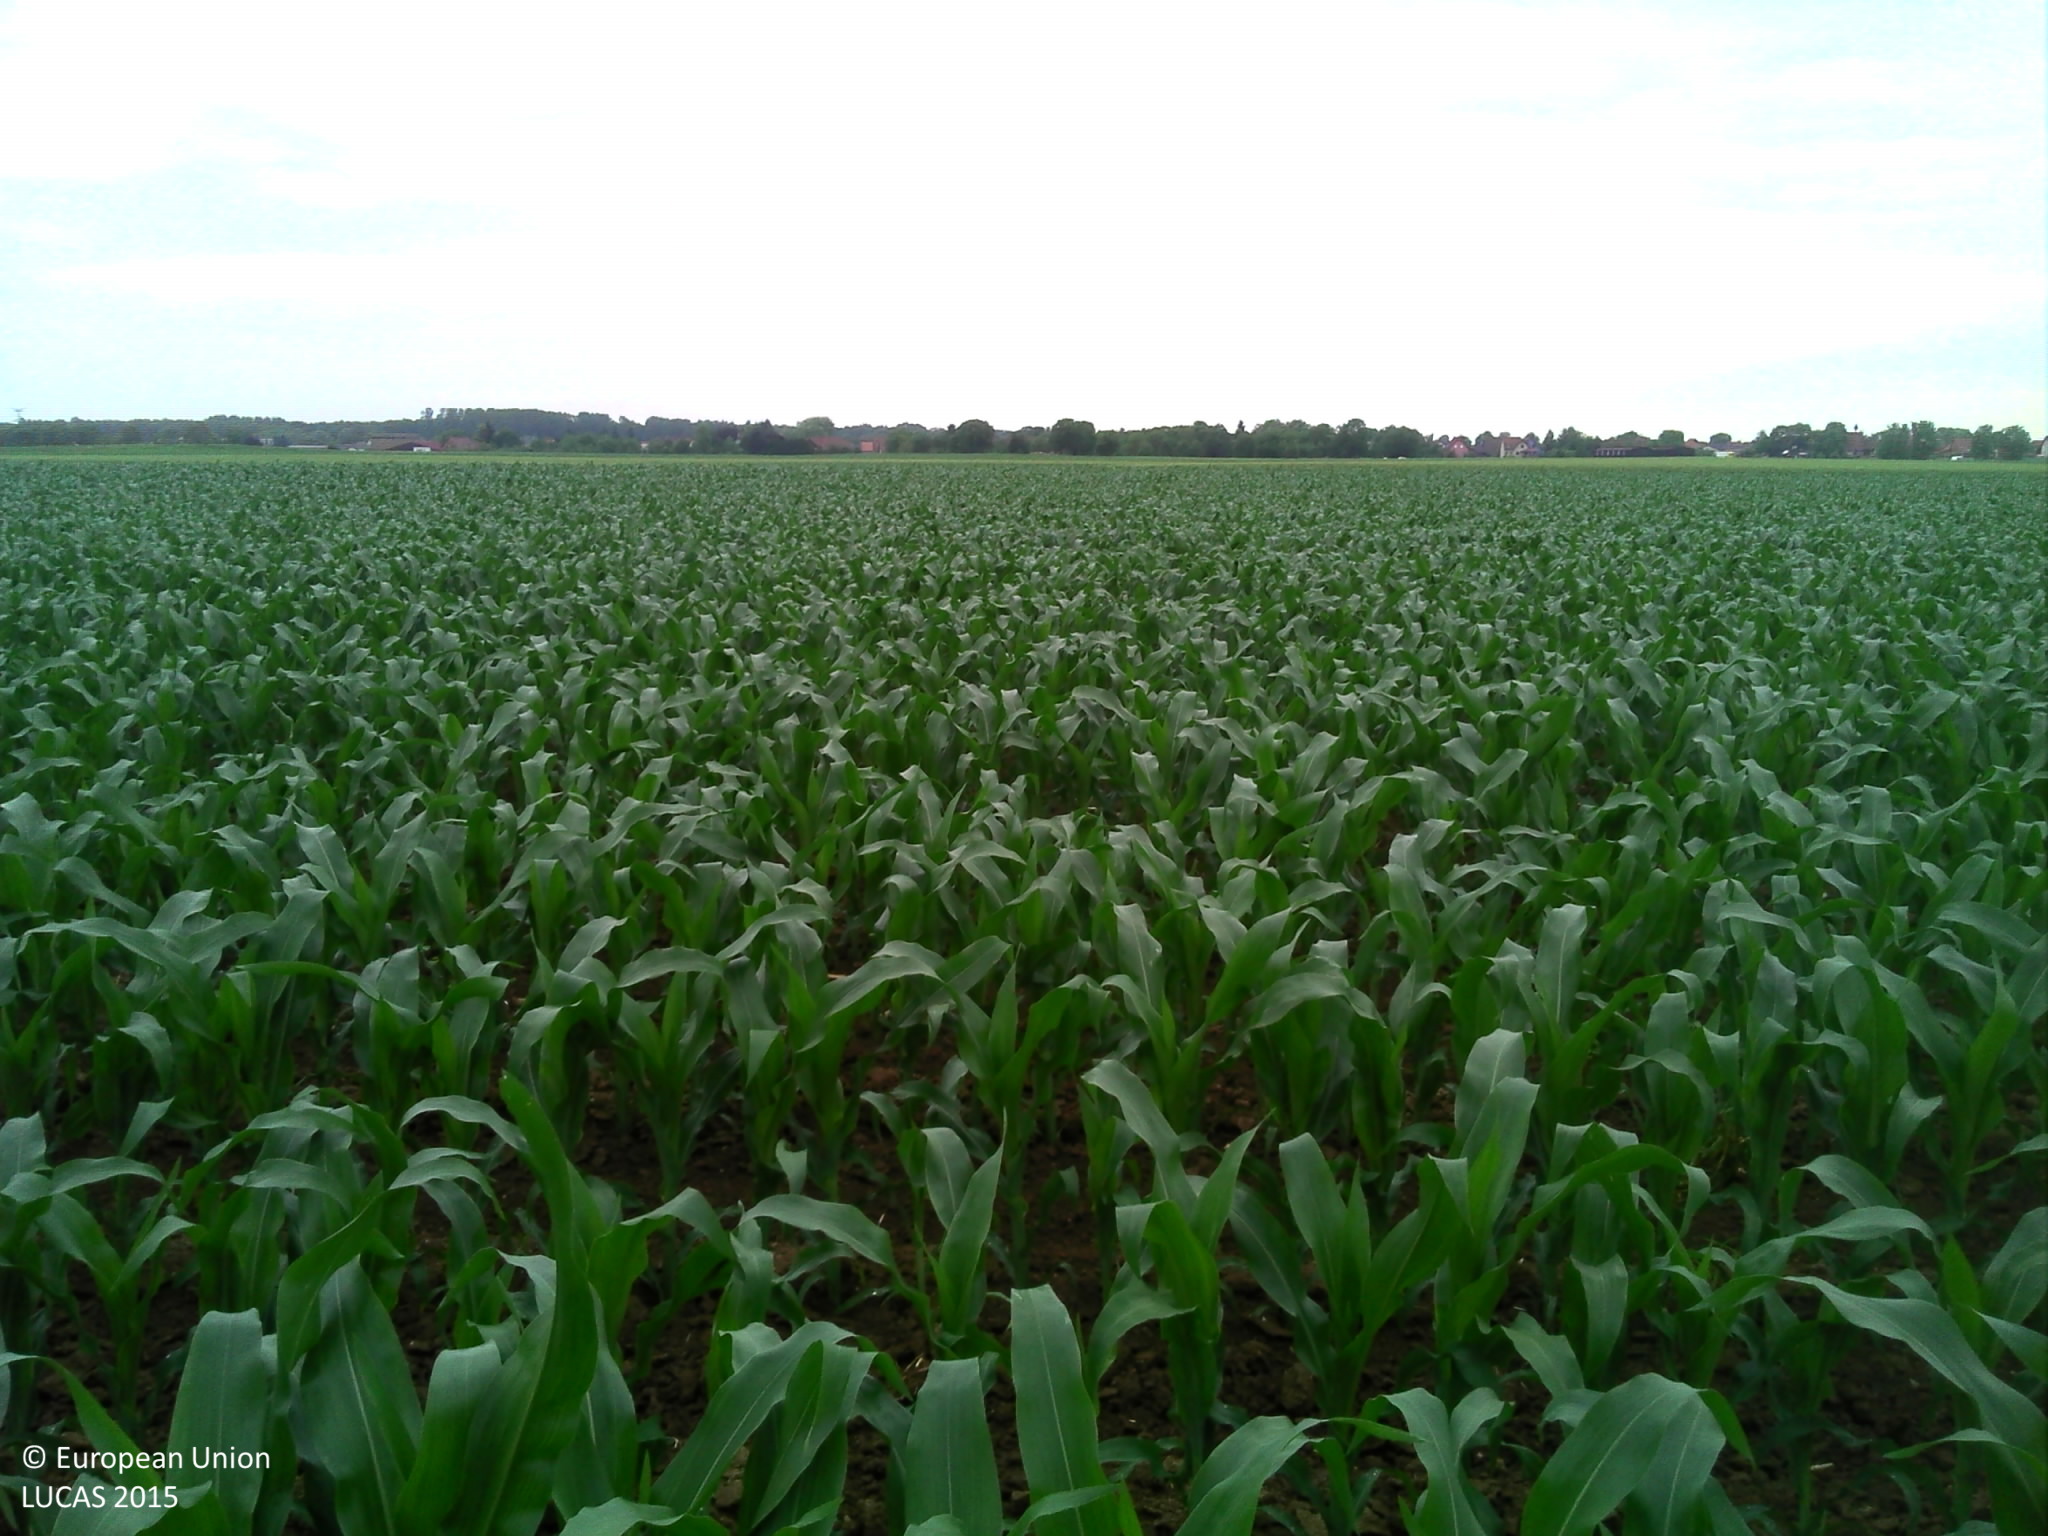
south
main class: Cropland
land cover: Maize
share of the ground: 10 - 25 %
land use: Agriculture (excluding fallow land and kitchen gardens)
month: June
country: FR
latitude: 48.4299
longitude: 7.5276
